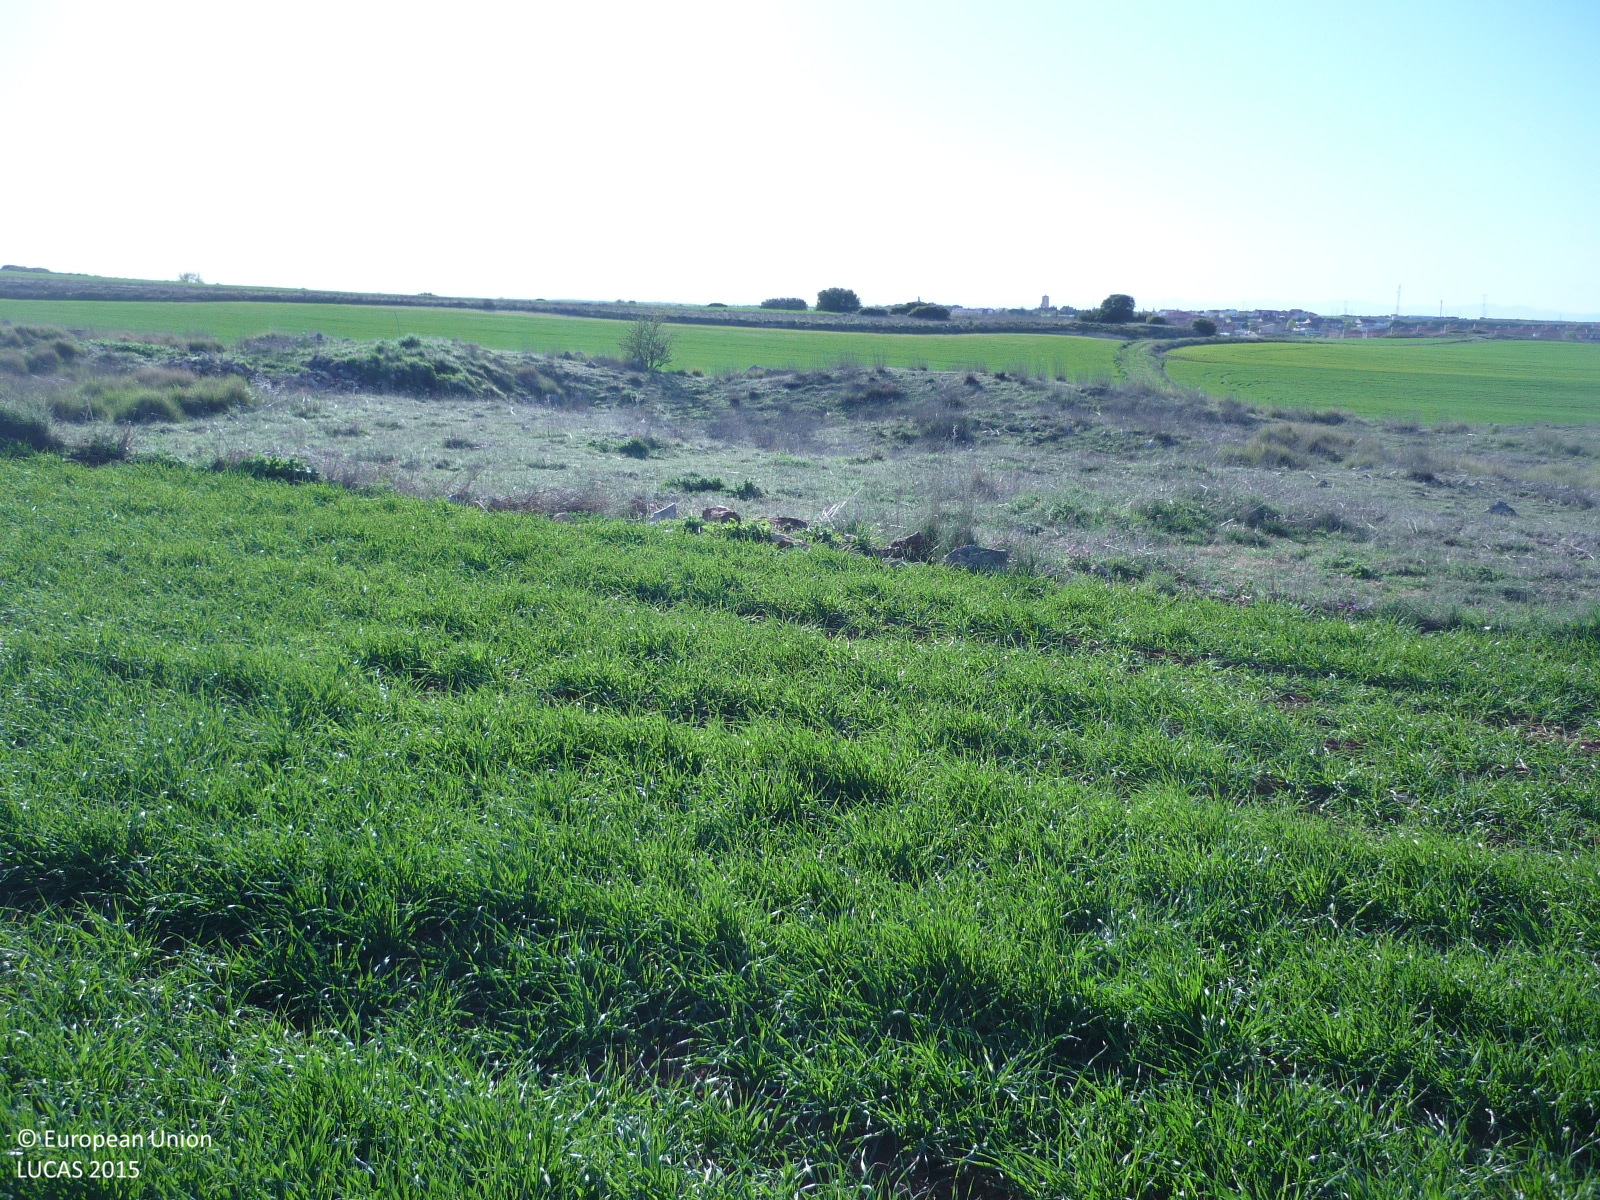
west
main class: Cropland
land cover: Barley
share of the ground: 50 - 75 %
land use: Agriculture (excluding fallow land and kitchen gardens)
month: March
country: ES
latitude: 40.3638
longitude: -3.3033
